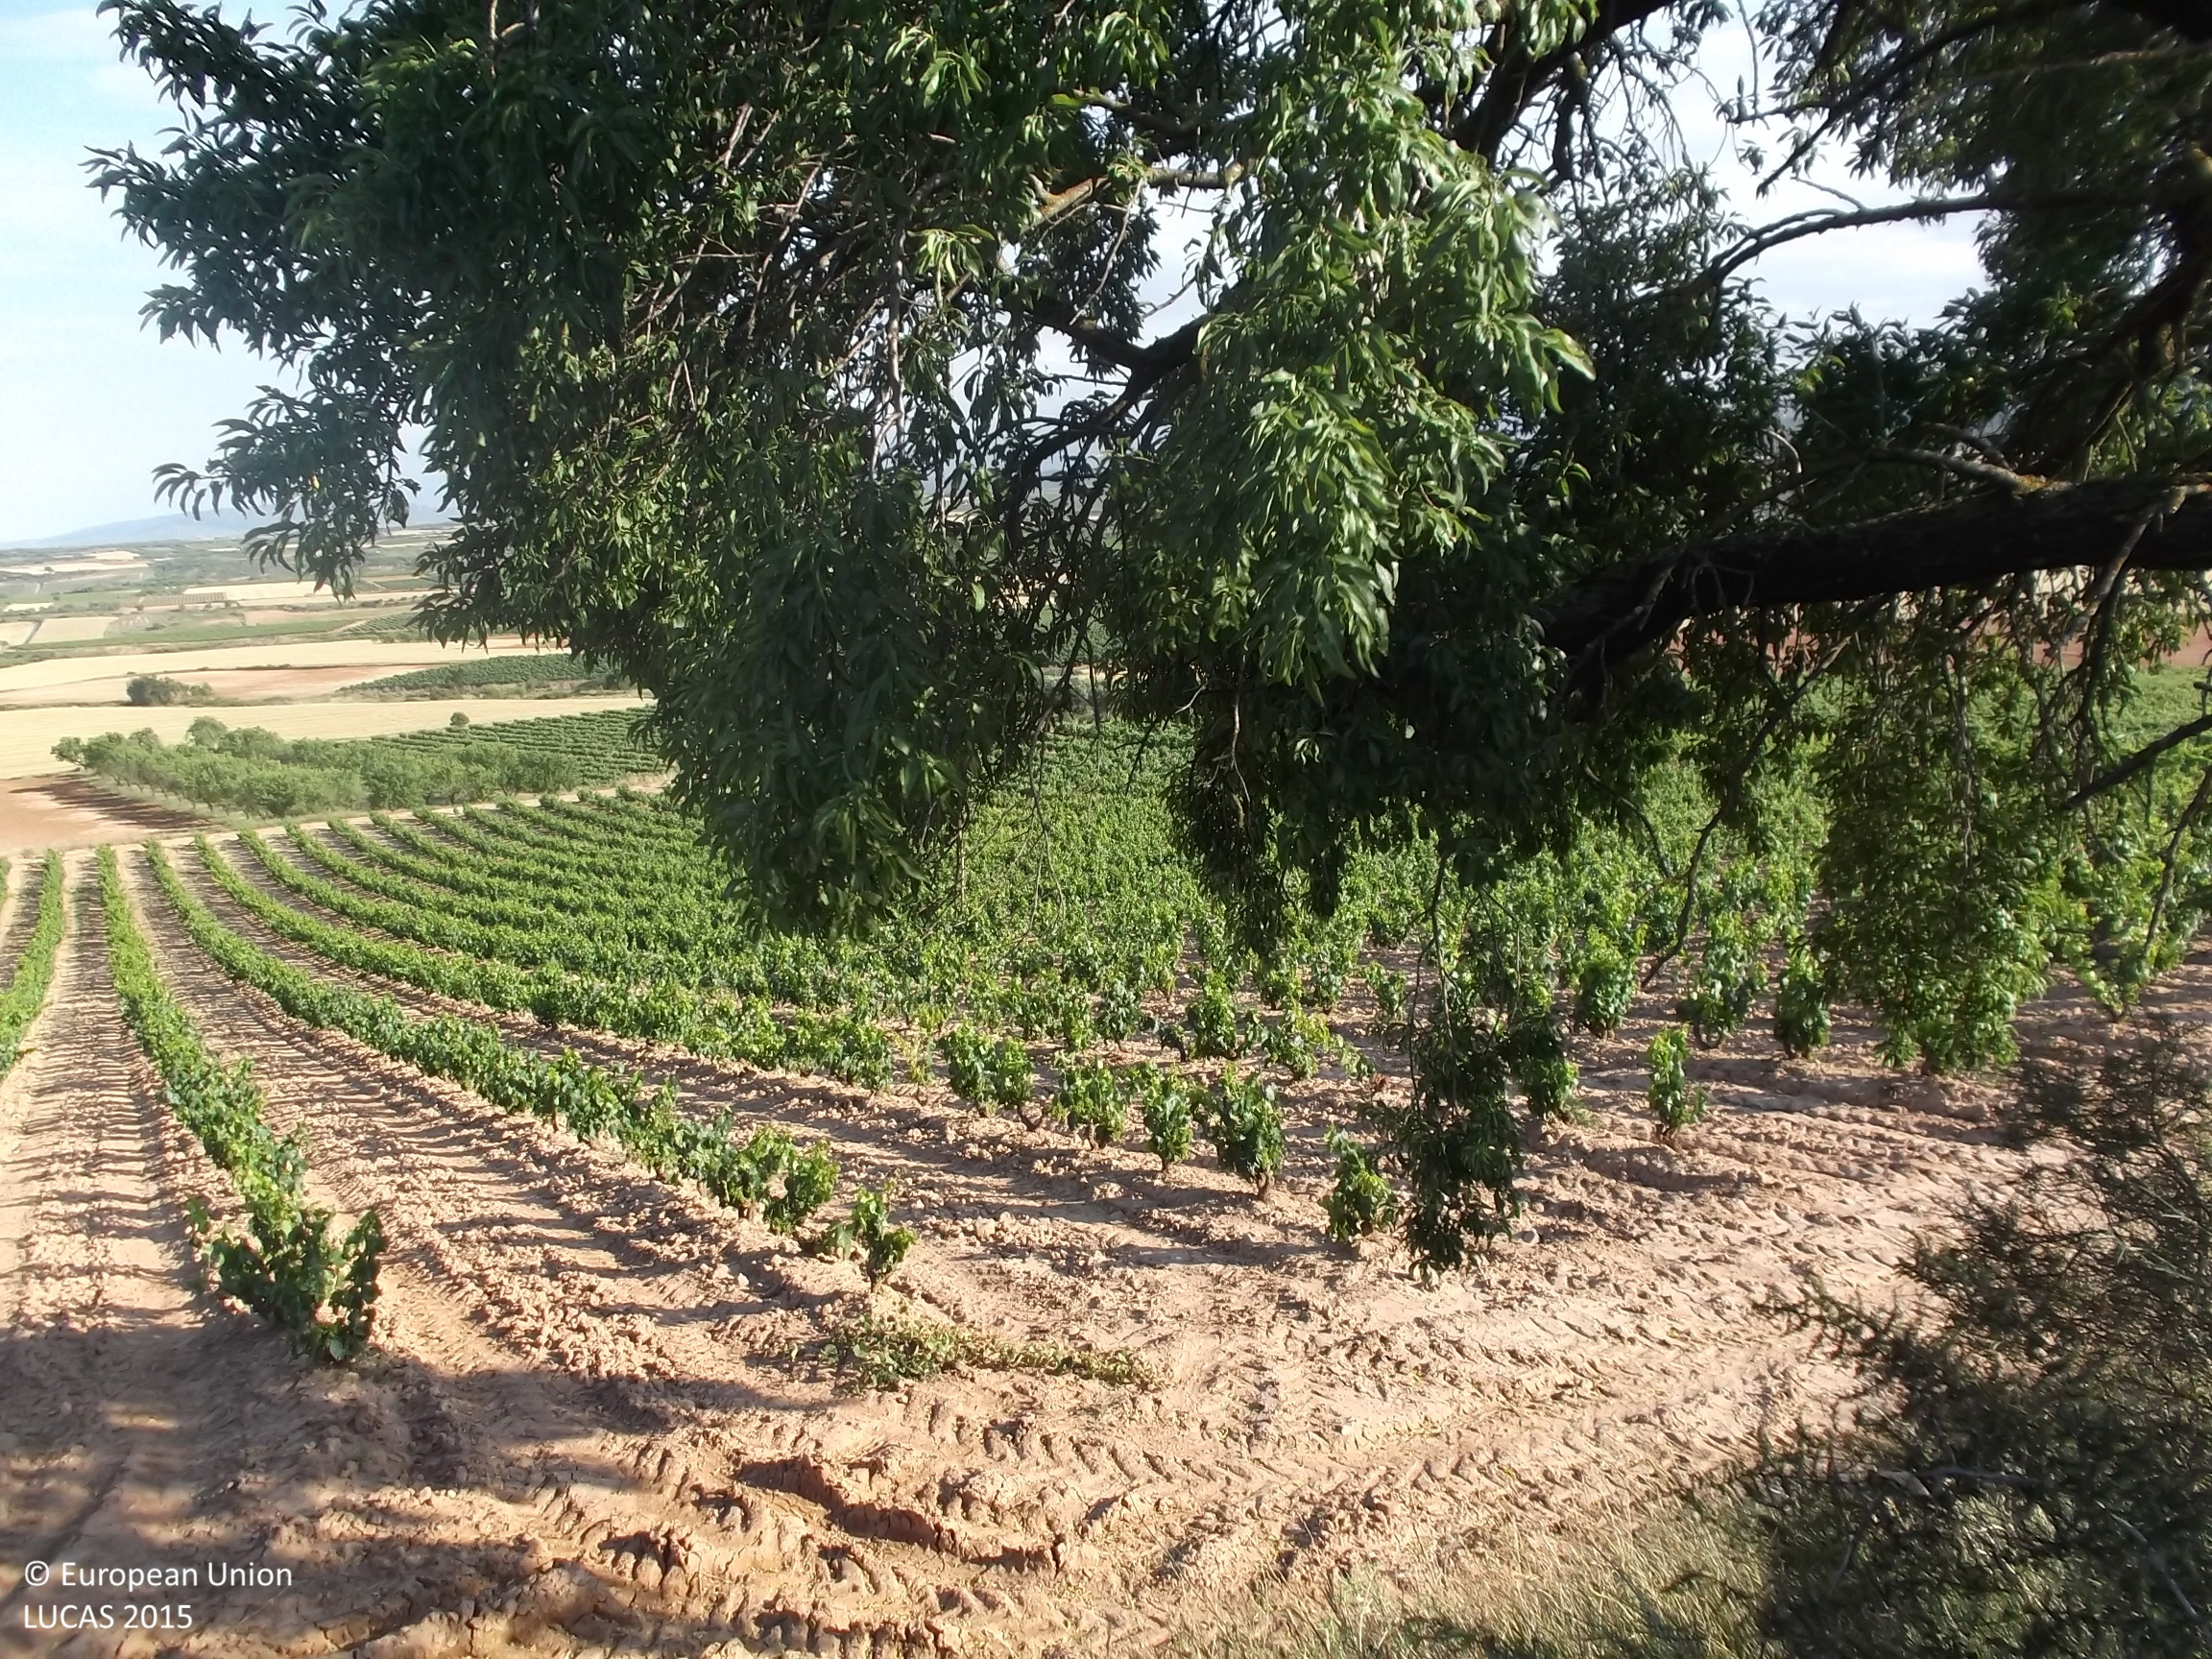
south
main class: Grassland
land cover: Grassland with sparse tree/shrub cover
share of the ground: 50 - 75 %
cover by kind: herbaceous plants 70 %, unconsolidated bare surface 25 %, broadleaved forest trees 5 %
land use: Semi-natural and natural areas not in use
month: June
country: ES
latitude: 42.3581
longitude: -2.1450
